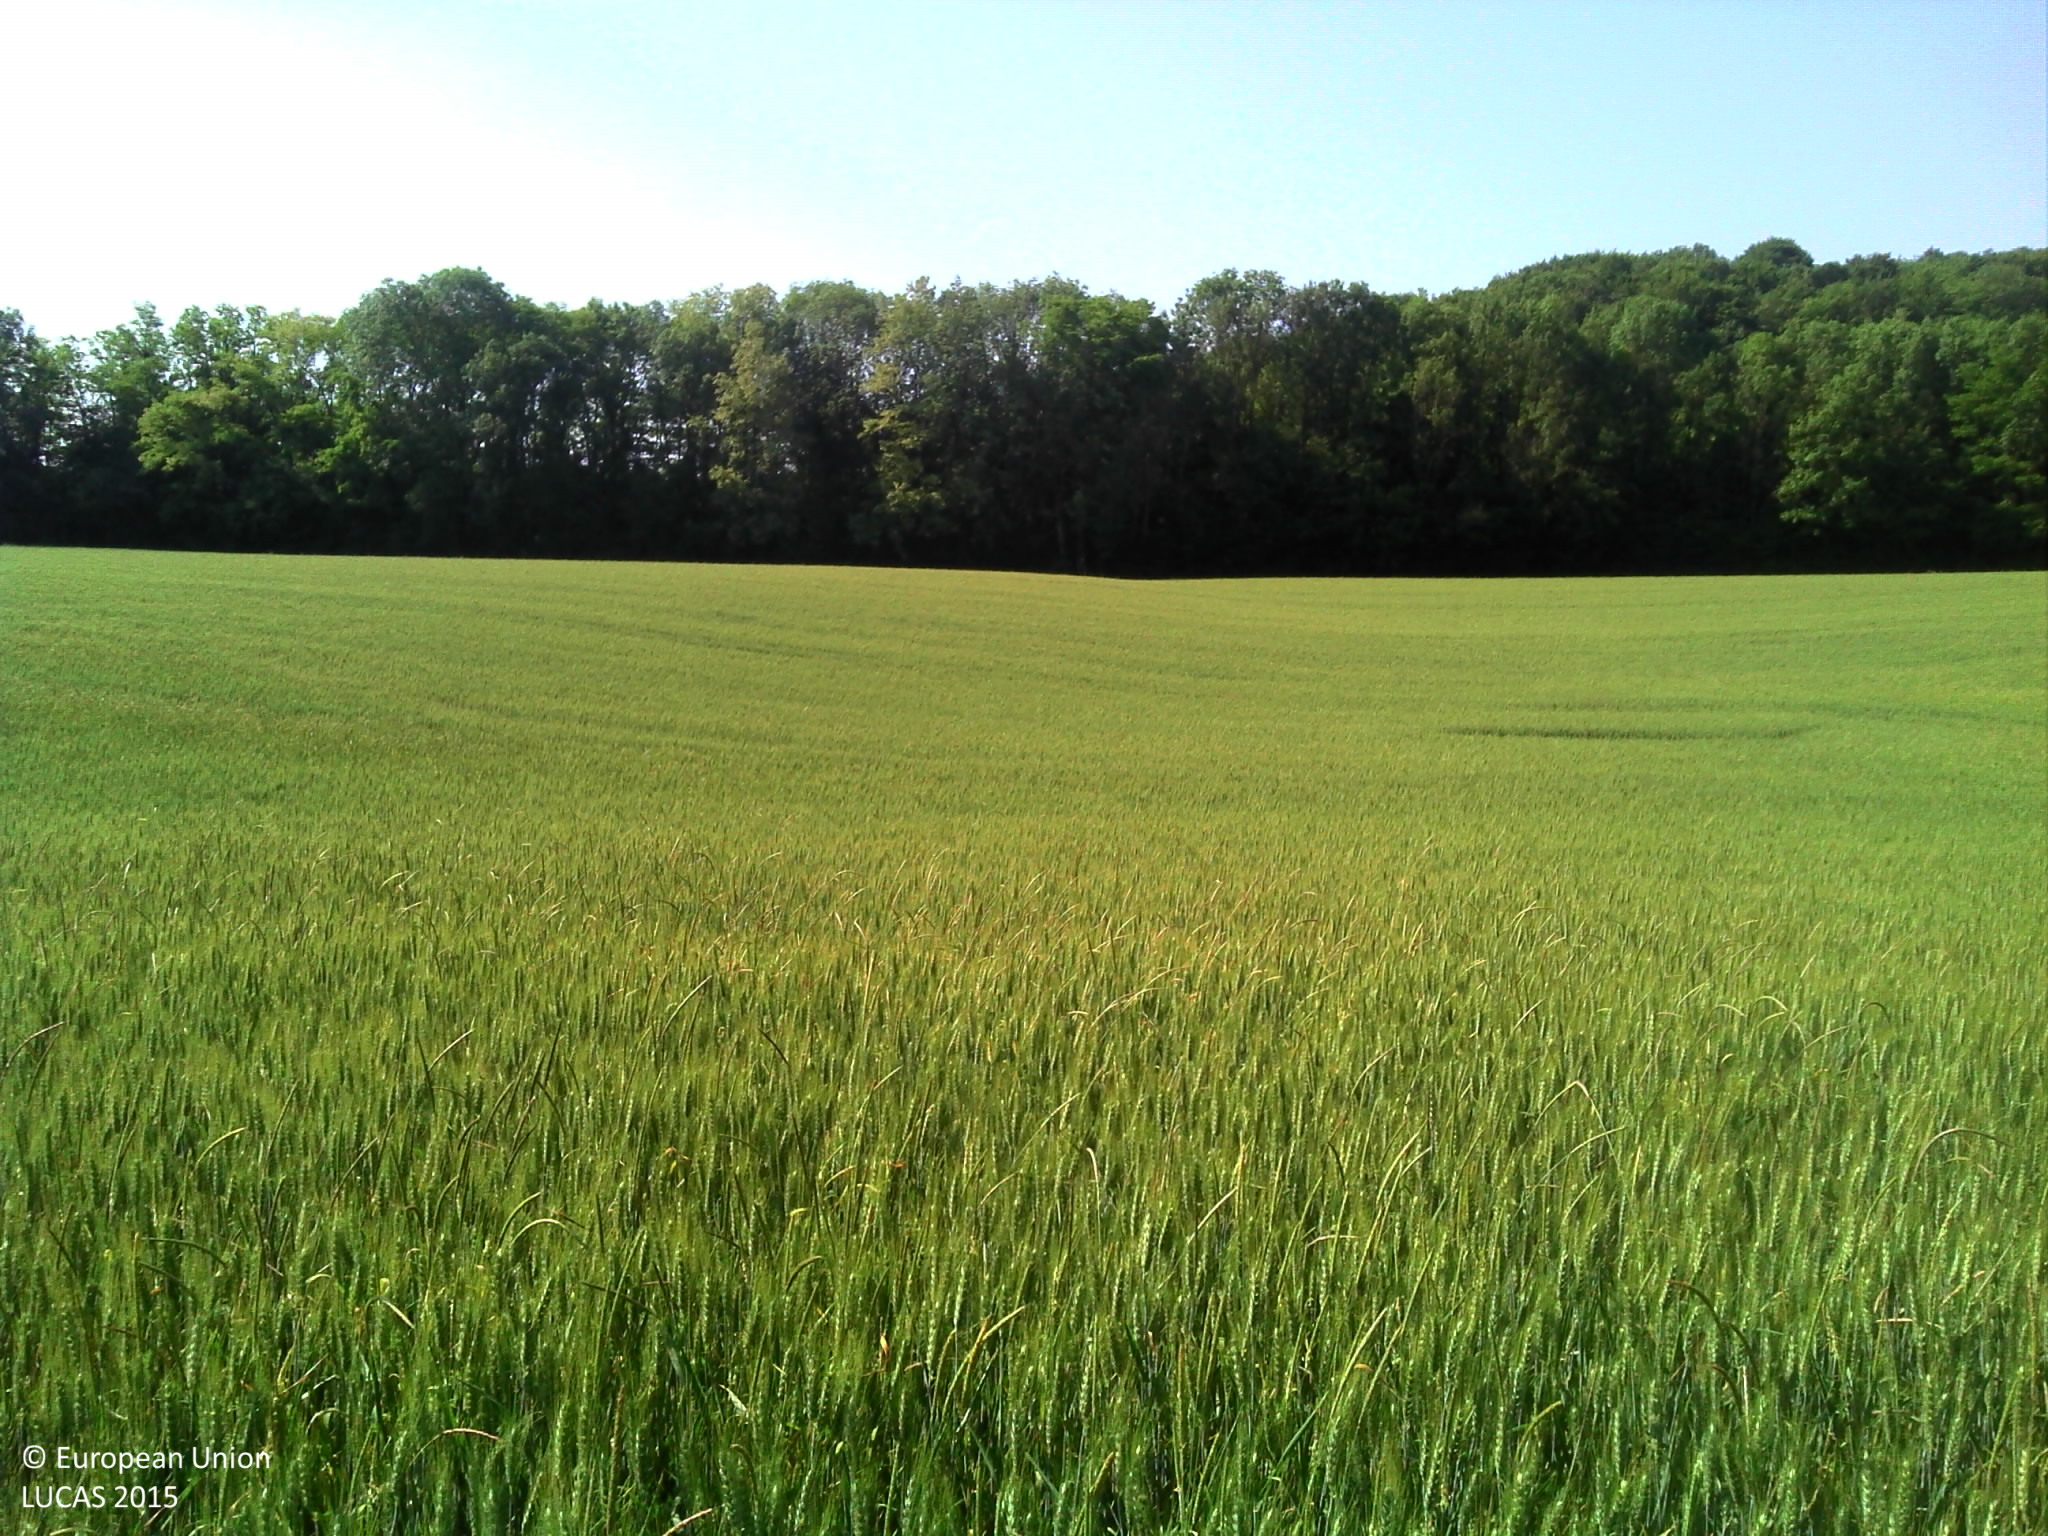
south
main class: Cropland
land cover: Durum wheat
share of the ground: > 75 %
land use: Agriculture (excluding fallow land and kitchen gardens)
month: June
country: FR
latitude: 47.5792
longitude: 6.1324
